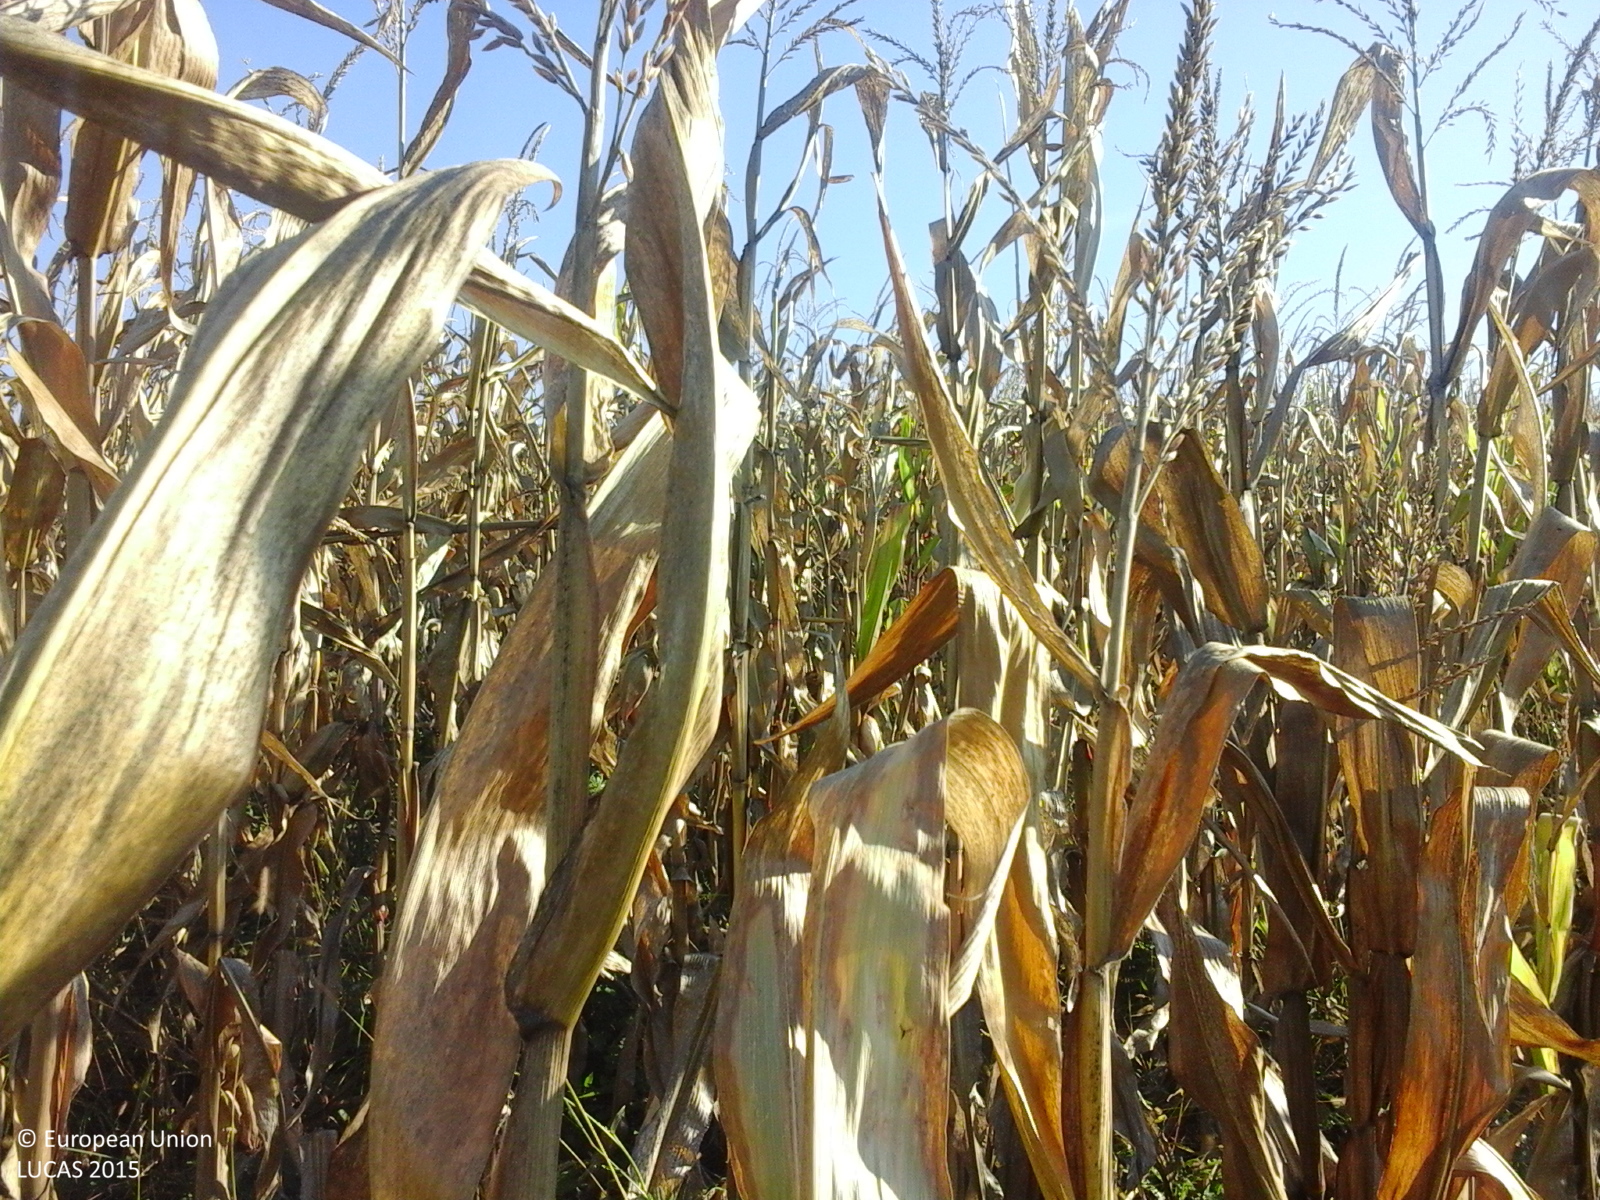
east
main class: Cropland
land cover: Maize
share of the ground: > 75 %
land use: Agriculture (excluding fallow land and kitchen gardens)
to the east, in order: Maize; Tracks; Grassland without tree/shrub cover
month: October
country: RO
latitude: 46.2262
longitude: 23.8809
